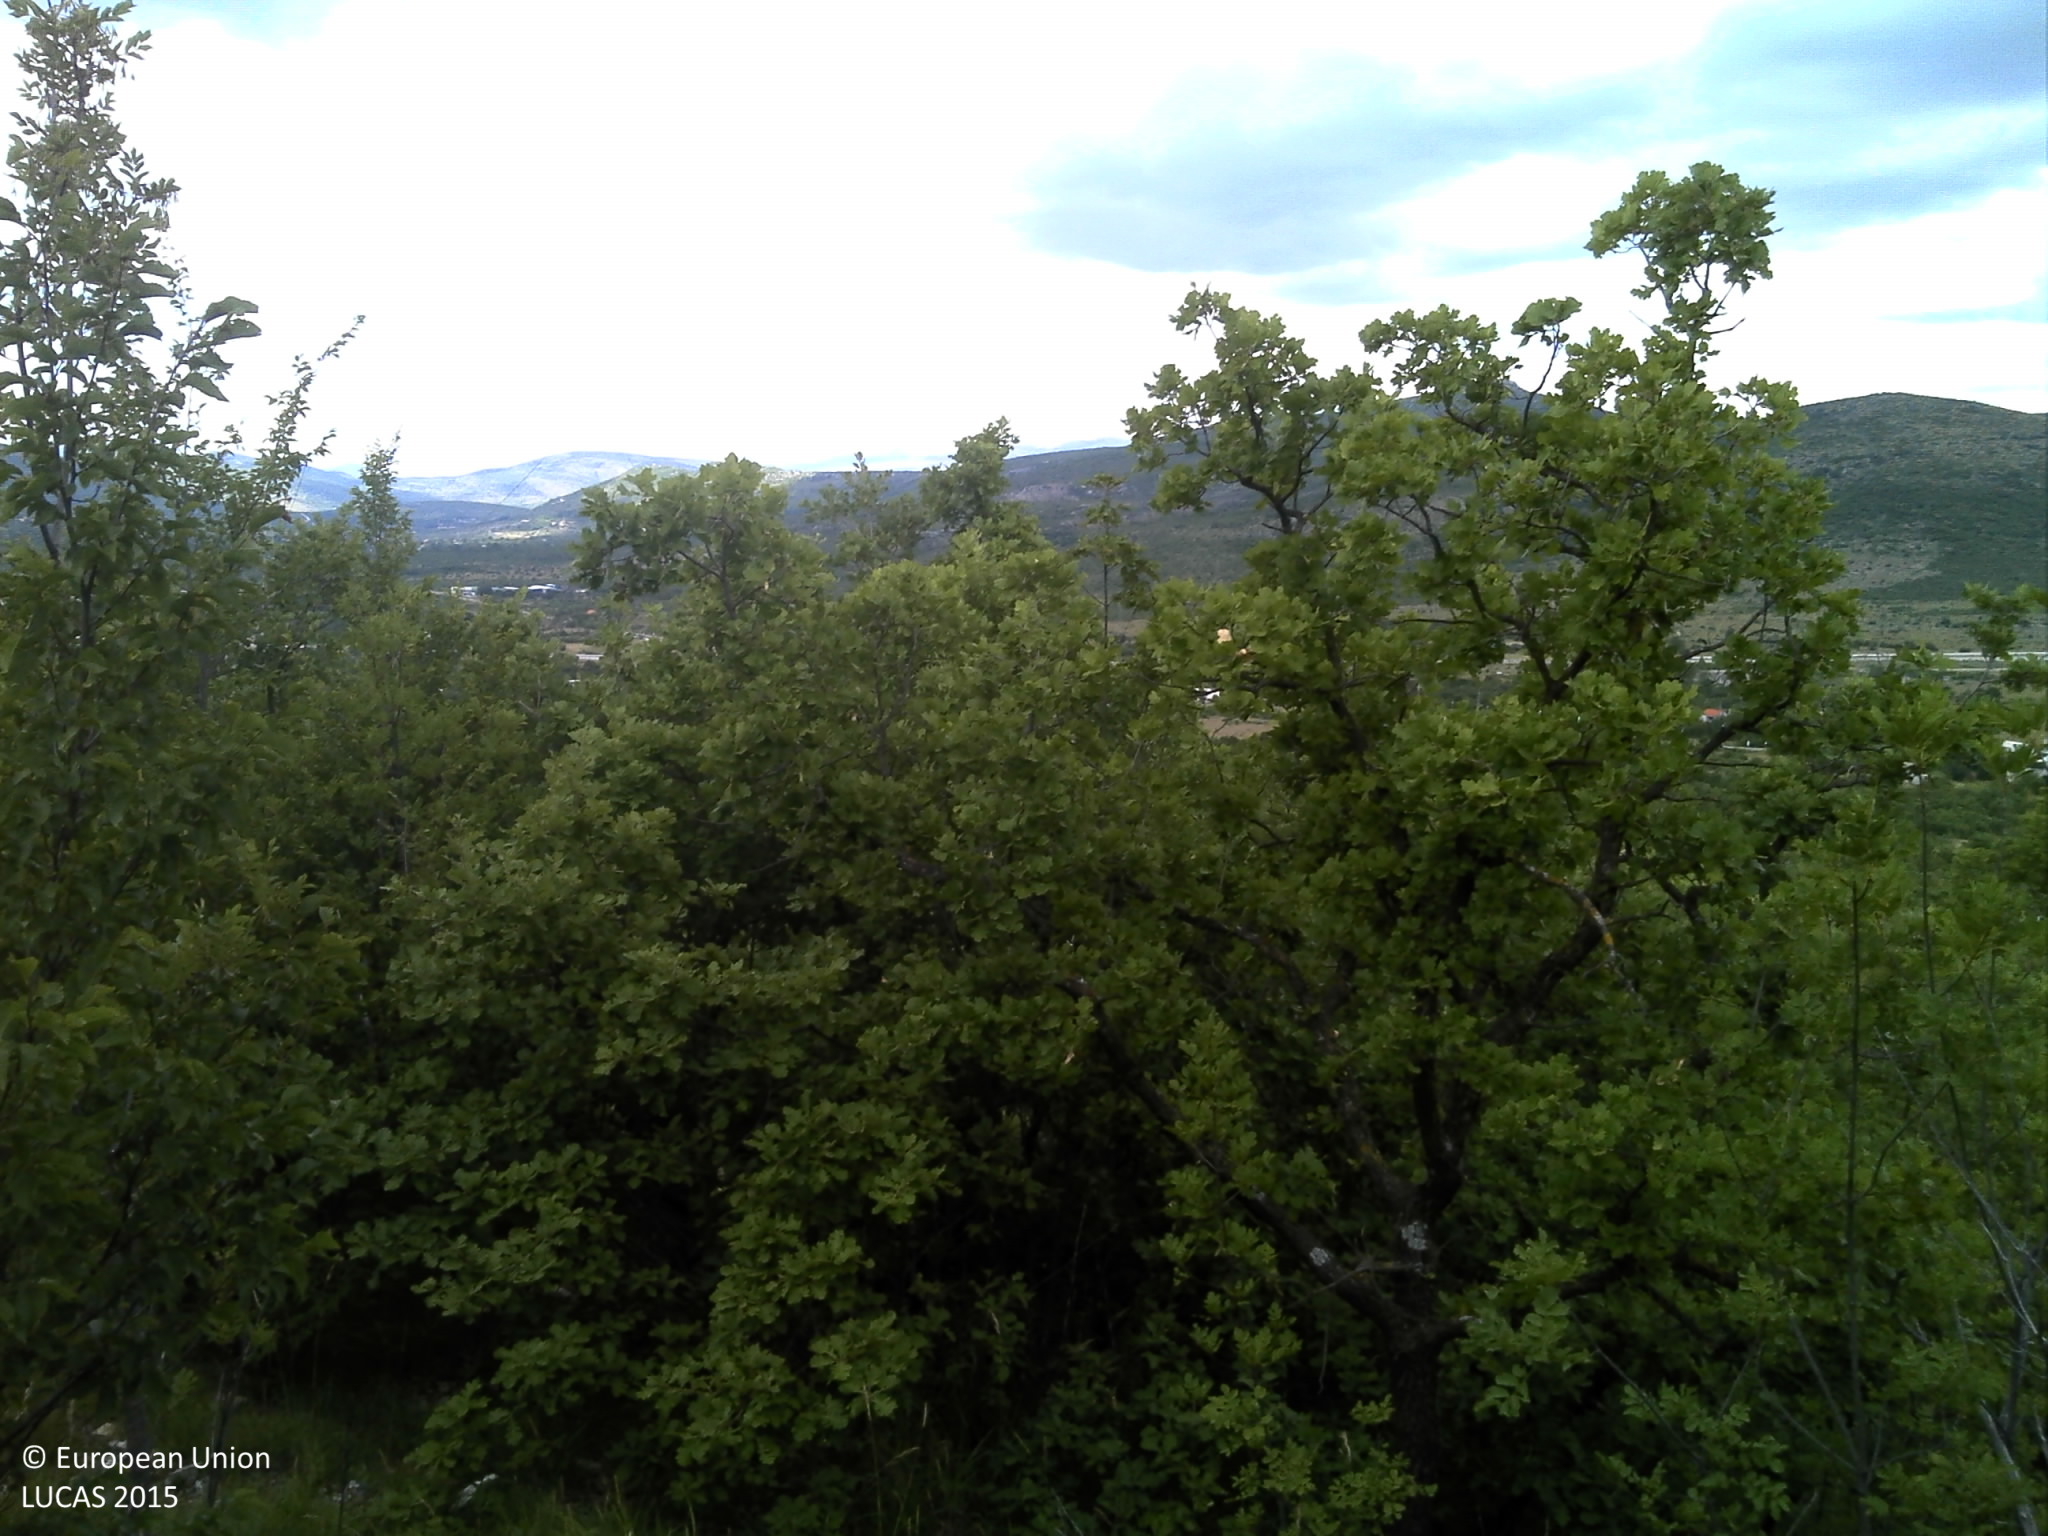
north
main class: Woodland
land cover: Broadleaved woodland
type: thermophilous deciduous forest
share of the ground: 50 - 75 %
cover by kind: broadleaved forest trees 65 %, herbaceous plants 15 %, coniferous forest trees 10 %, consolidated bare surface 10 %
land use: Semi-natural and natural areas not in use
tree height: > 5 m
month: June
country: HR
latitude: 43.5846
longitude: 16.5180
